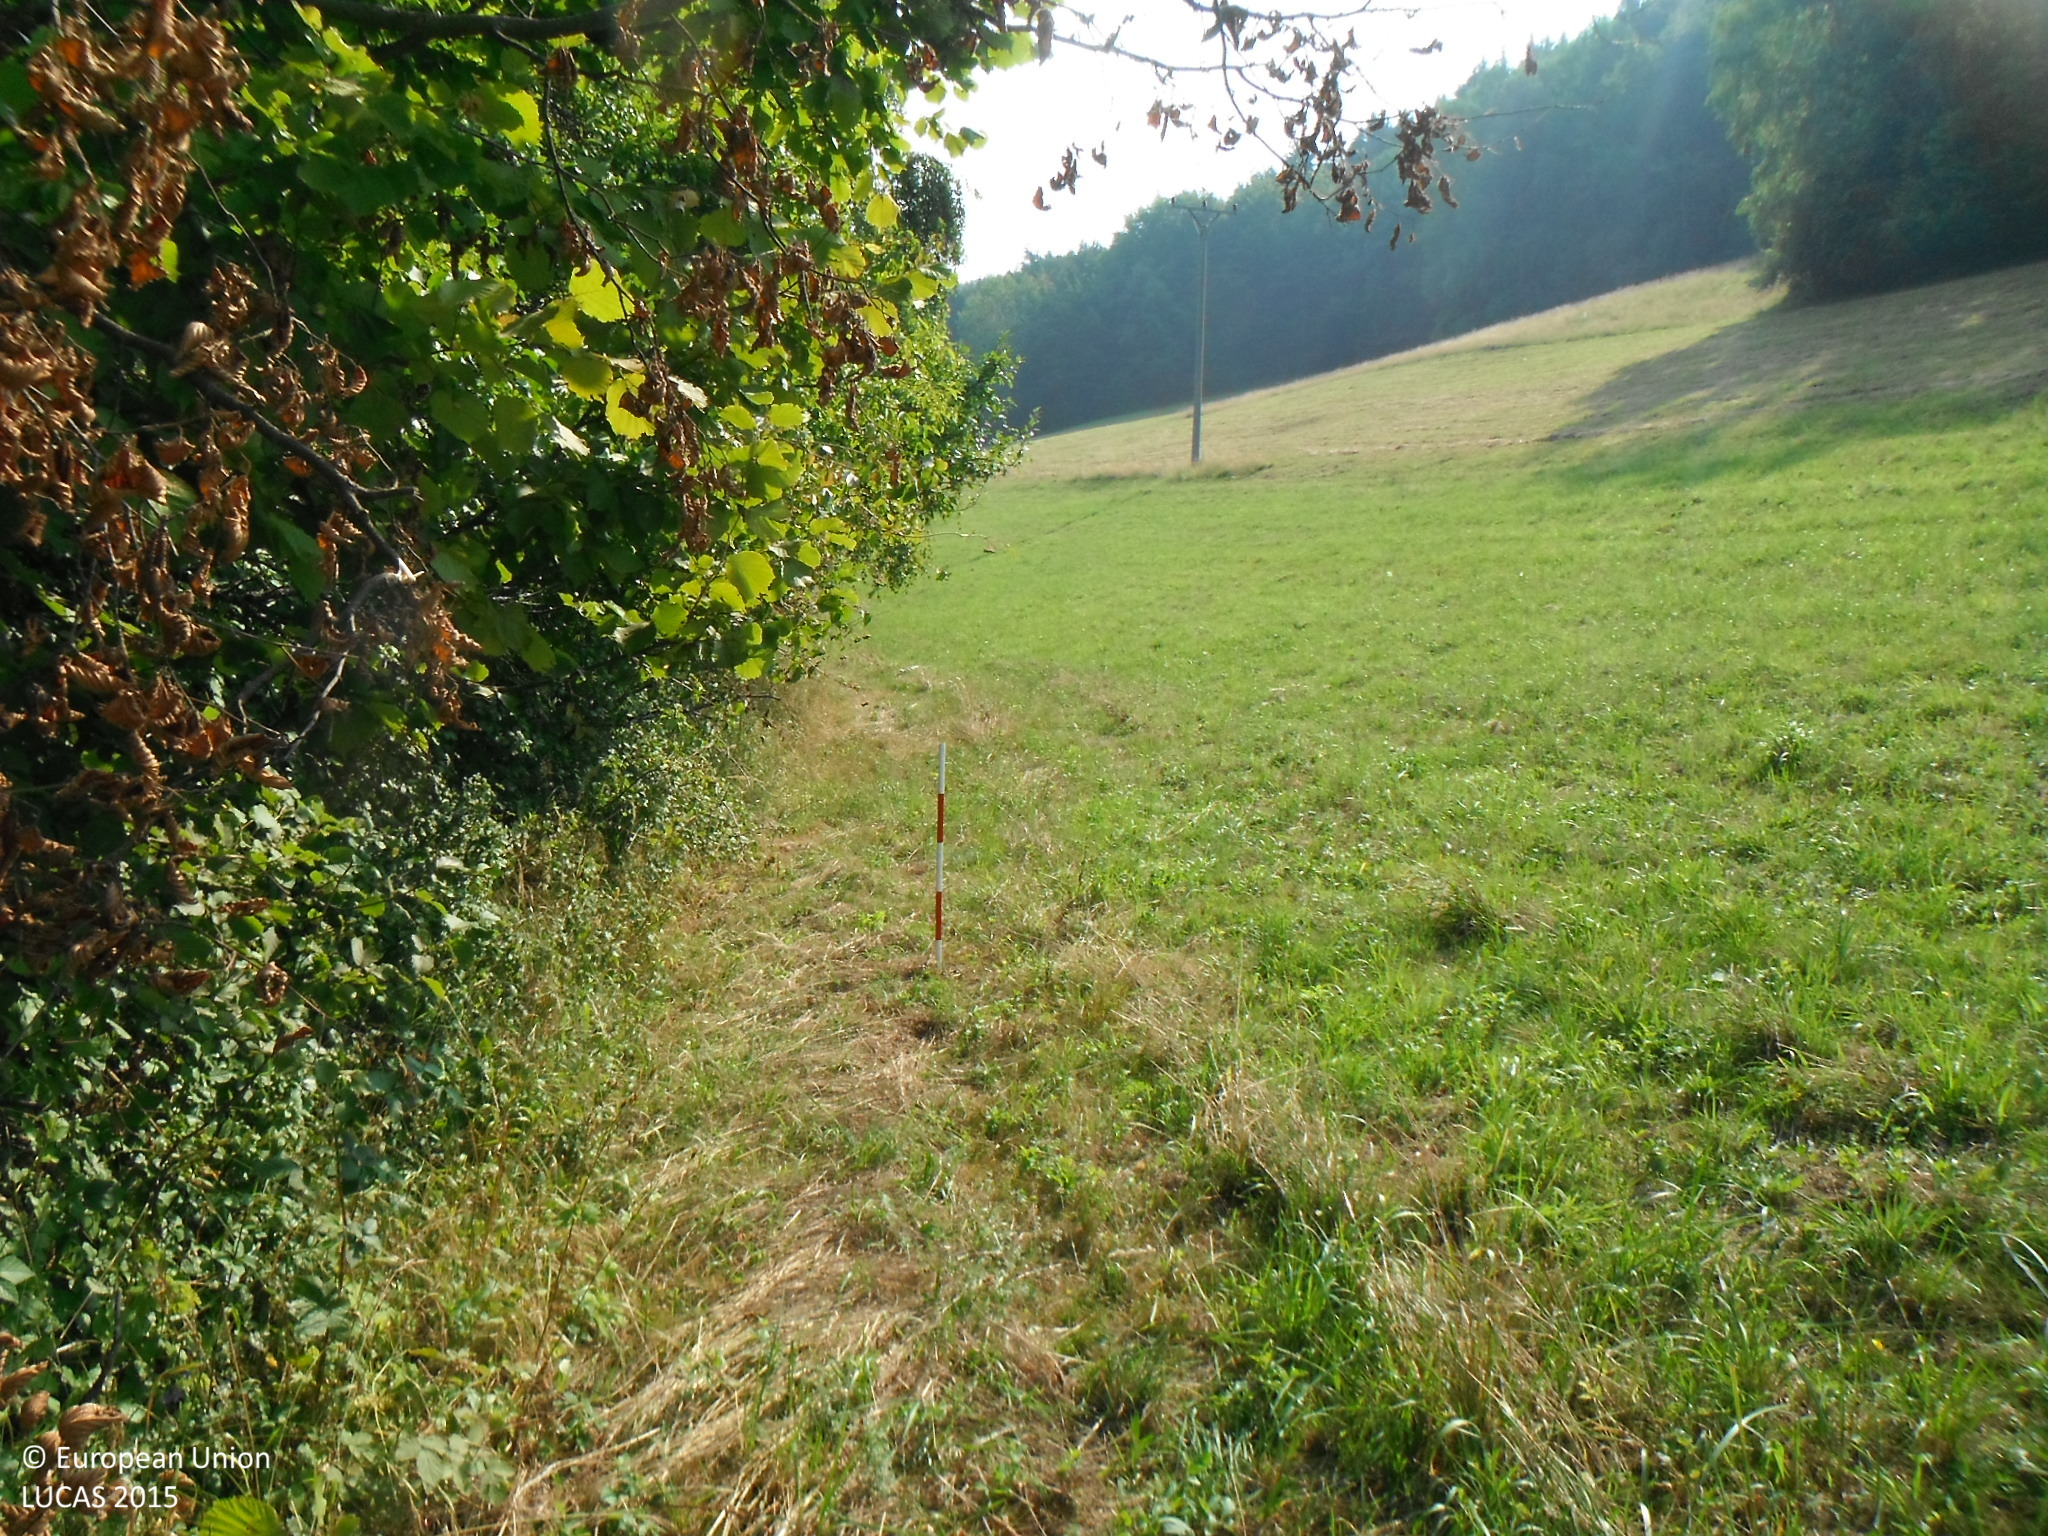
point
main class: Grassland
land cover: Grassland without tree/shrub cover
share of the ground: > 75 %
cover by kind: herbaceous plants 100 %
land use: Agriculture (excluding fallow land and kitchen gardens)
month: August
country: SK
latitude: 49.1332
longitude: 18.3913
